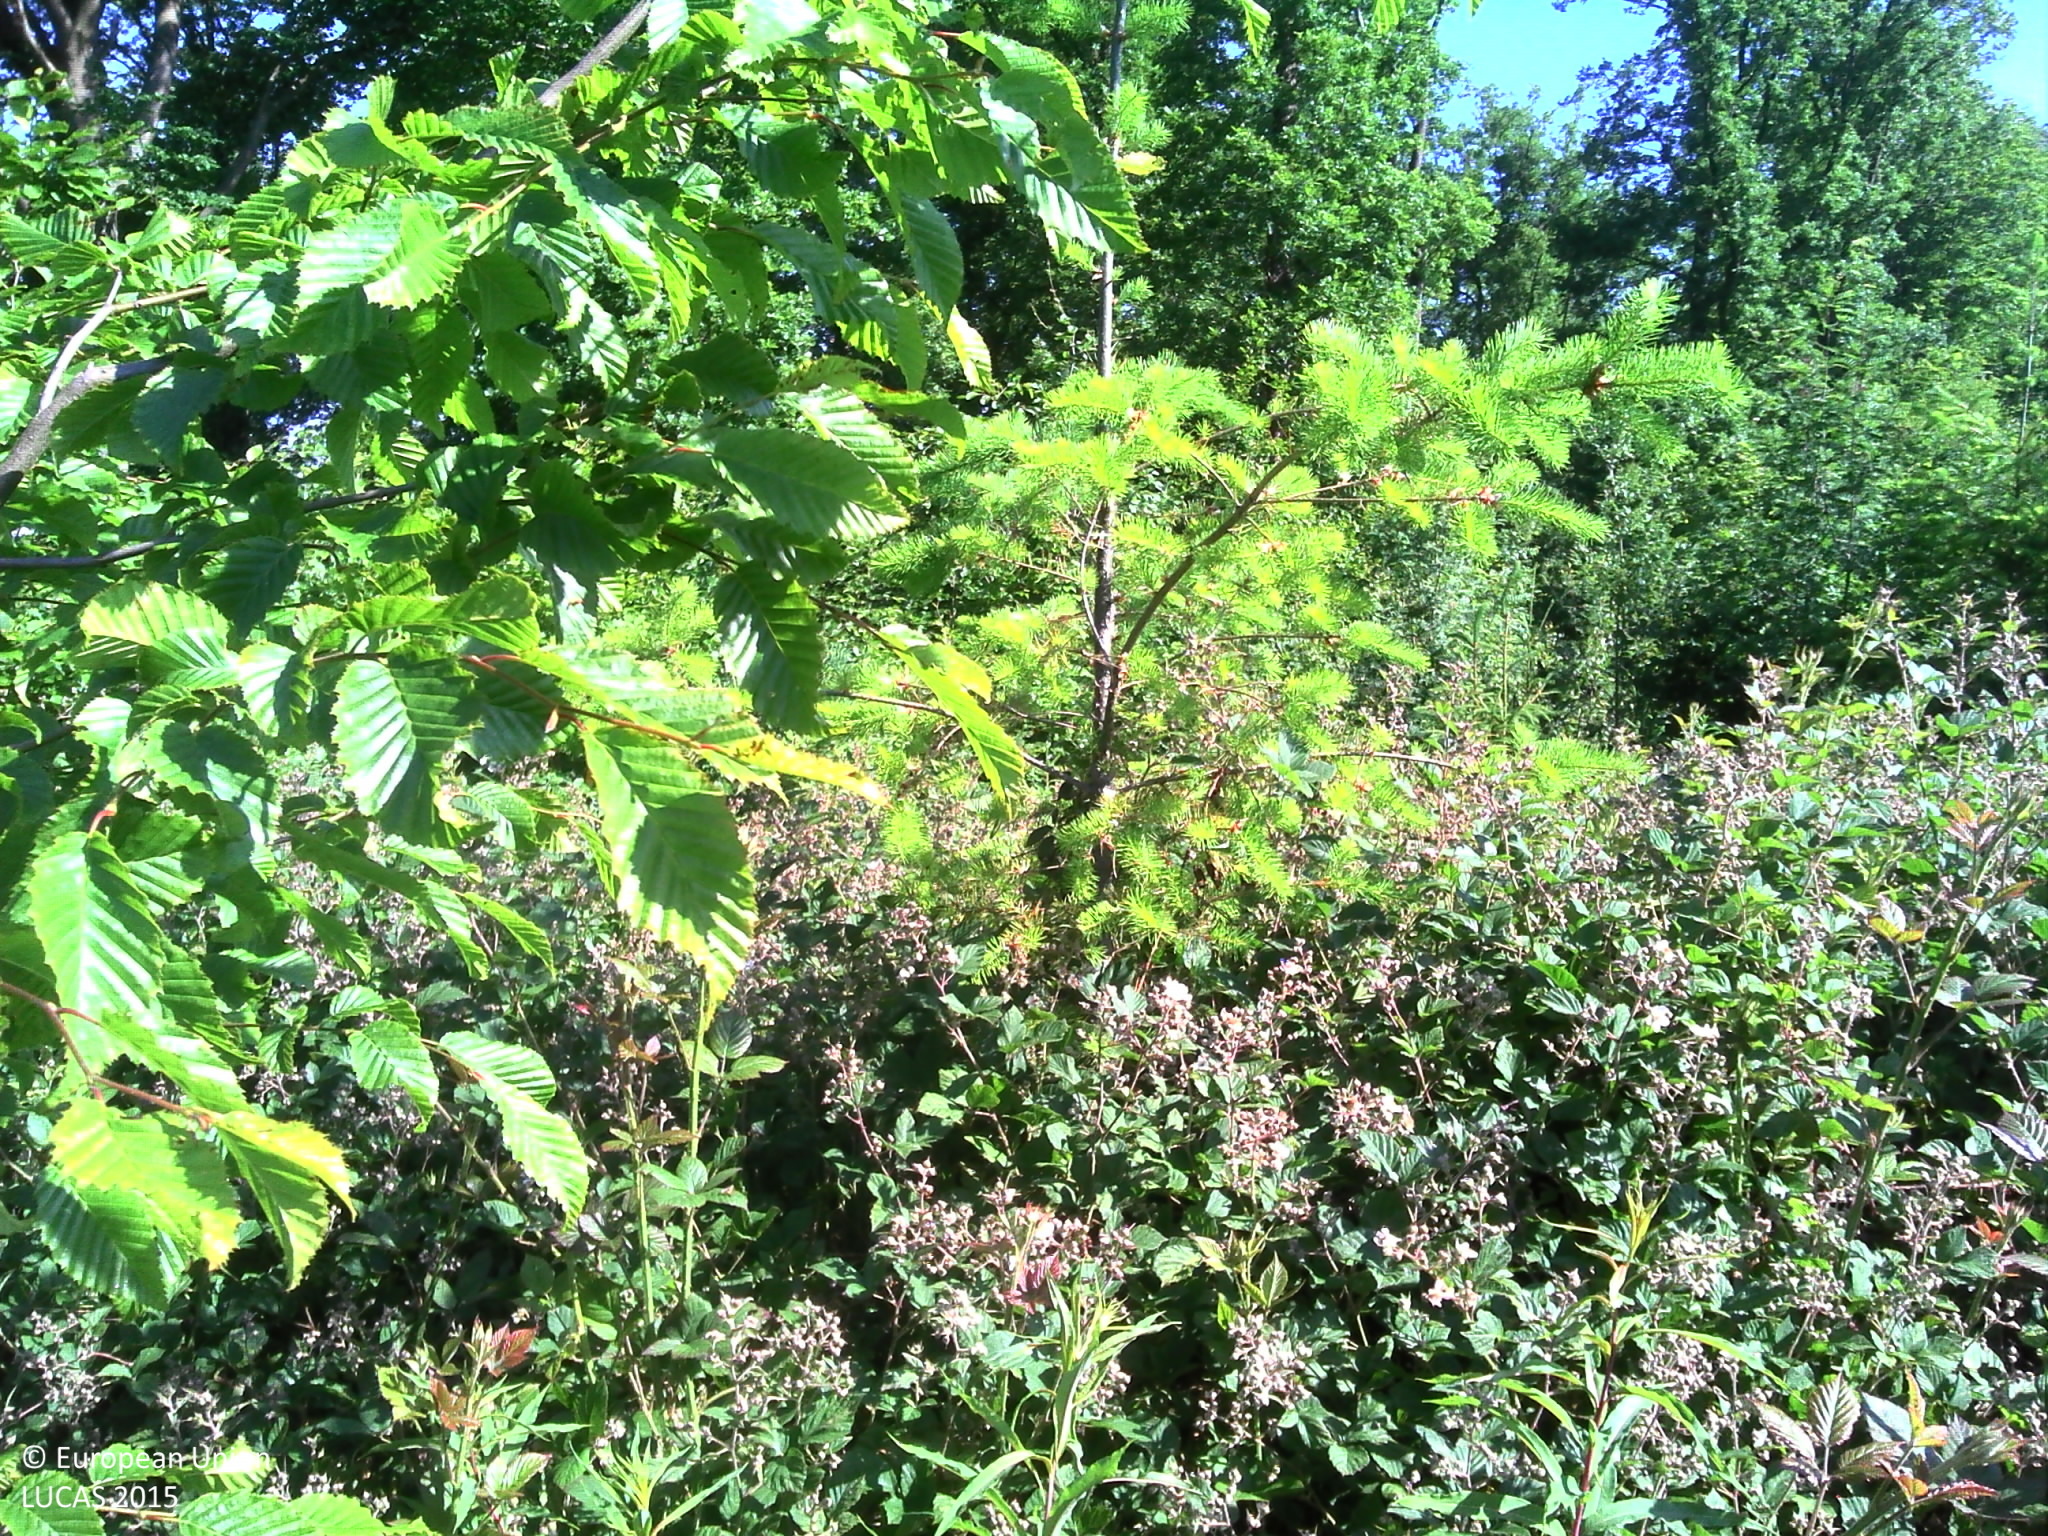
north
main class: Woodland
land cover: Other mixed woodland
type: acidophilous oak and oak-birch forest
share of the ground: 10 - 25 %
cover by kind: shrubs 50 %, herbaceous plants 30 %, coniferous forest trees 10 %, broadleaved forest trees 10 %
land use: Forestry
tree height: > 5 m
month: June
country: BE
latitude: 50.1968
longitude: 5.3331
